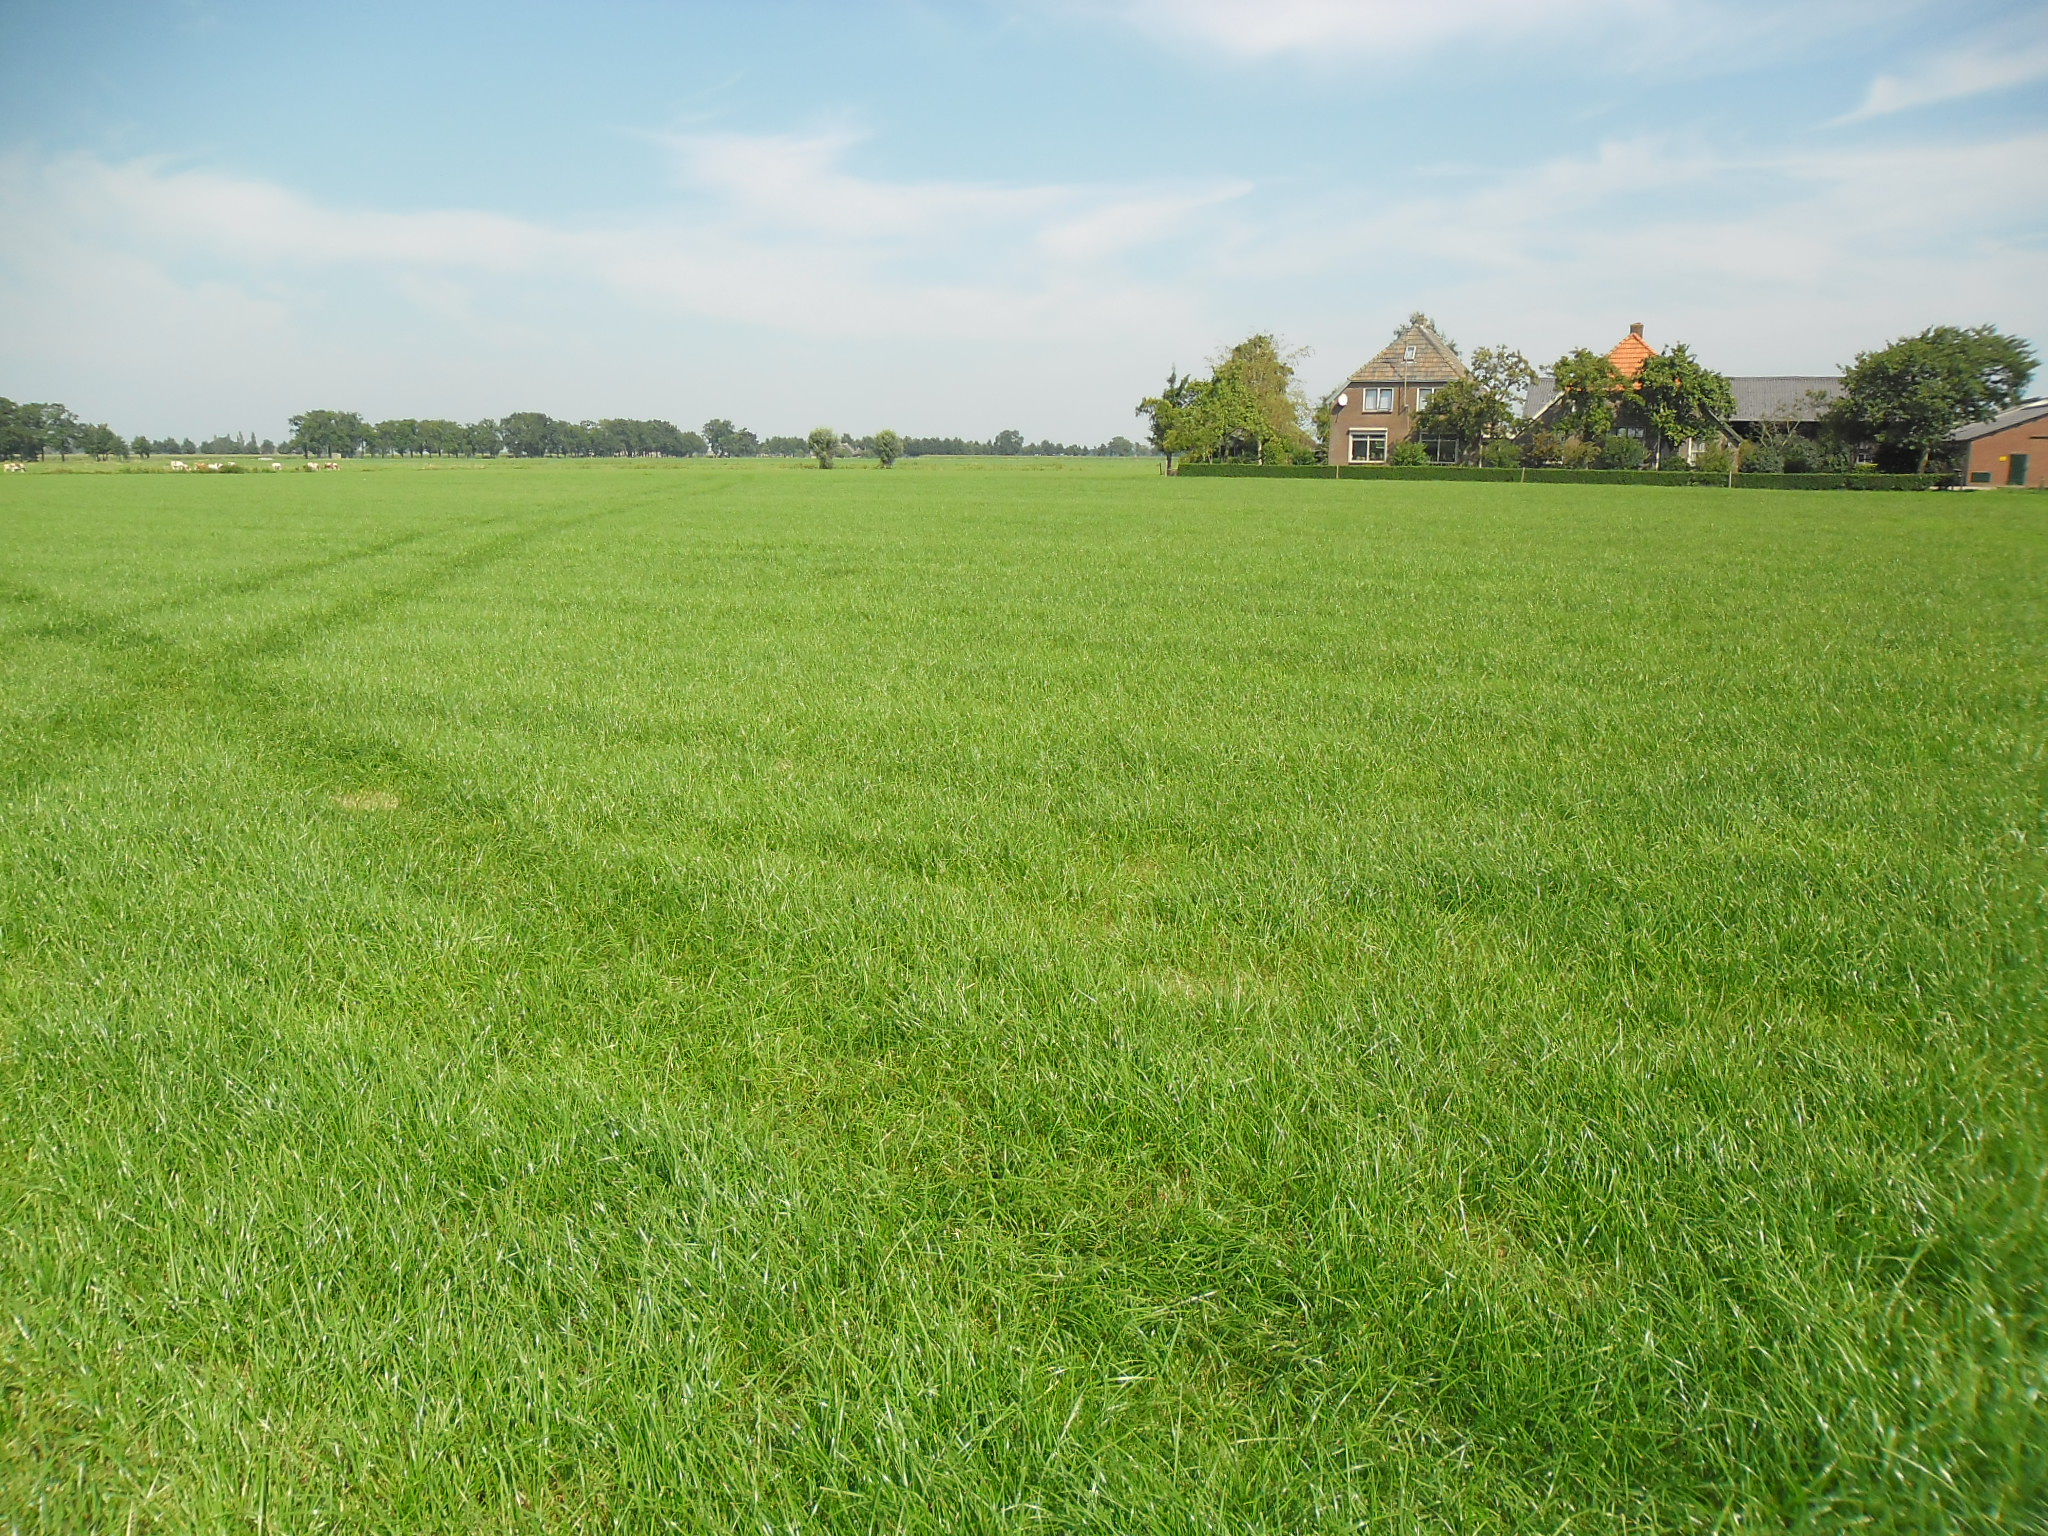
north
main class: Grassland
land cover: Grassland without tree/shrub cover
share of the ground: > 75 %
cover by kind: herbaceous plants 100 %
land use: Agriculture (excluding fallow land and kitchen gardens)
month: August
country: NL
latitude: 52.4064
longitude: 6.1923
